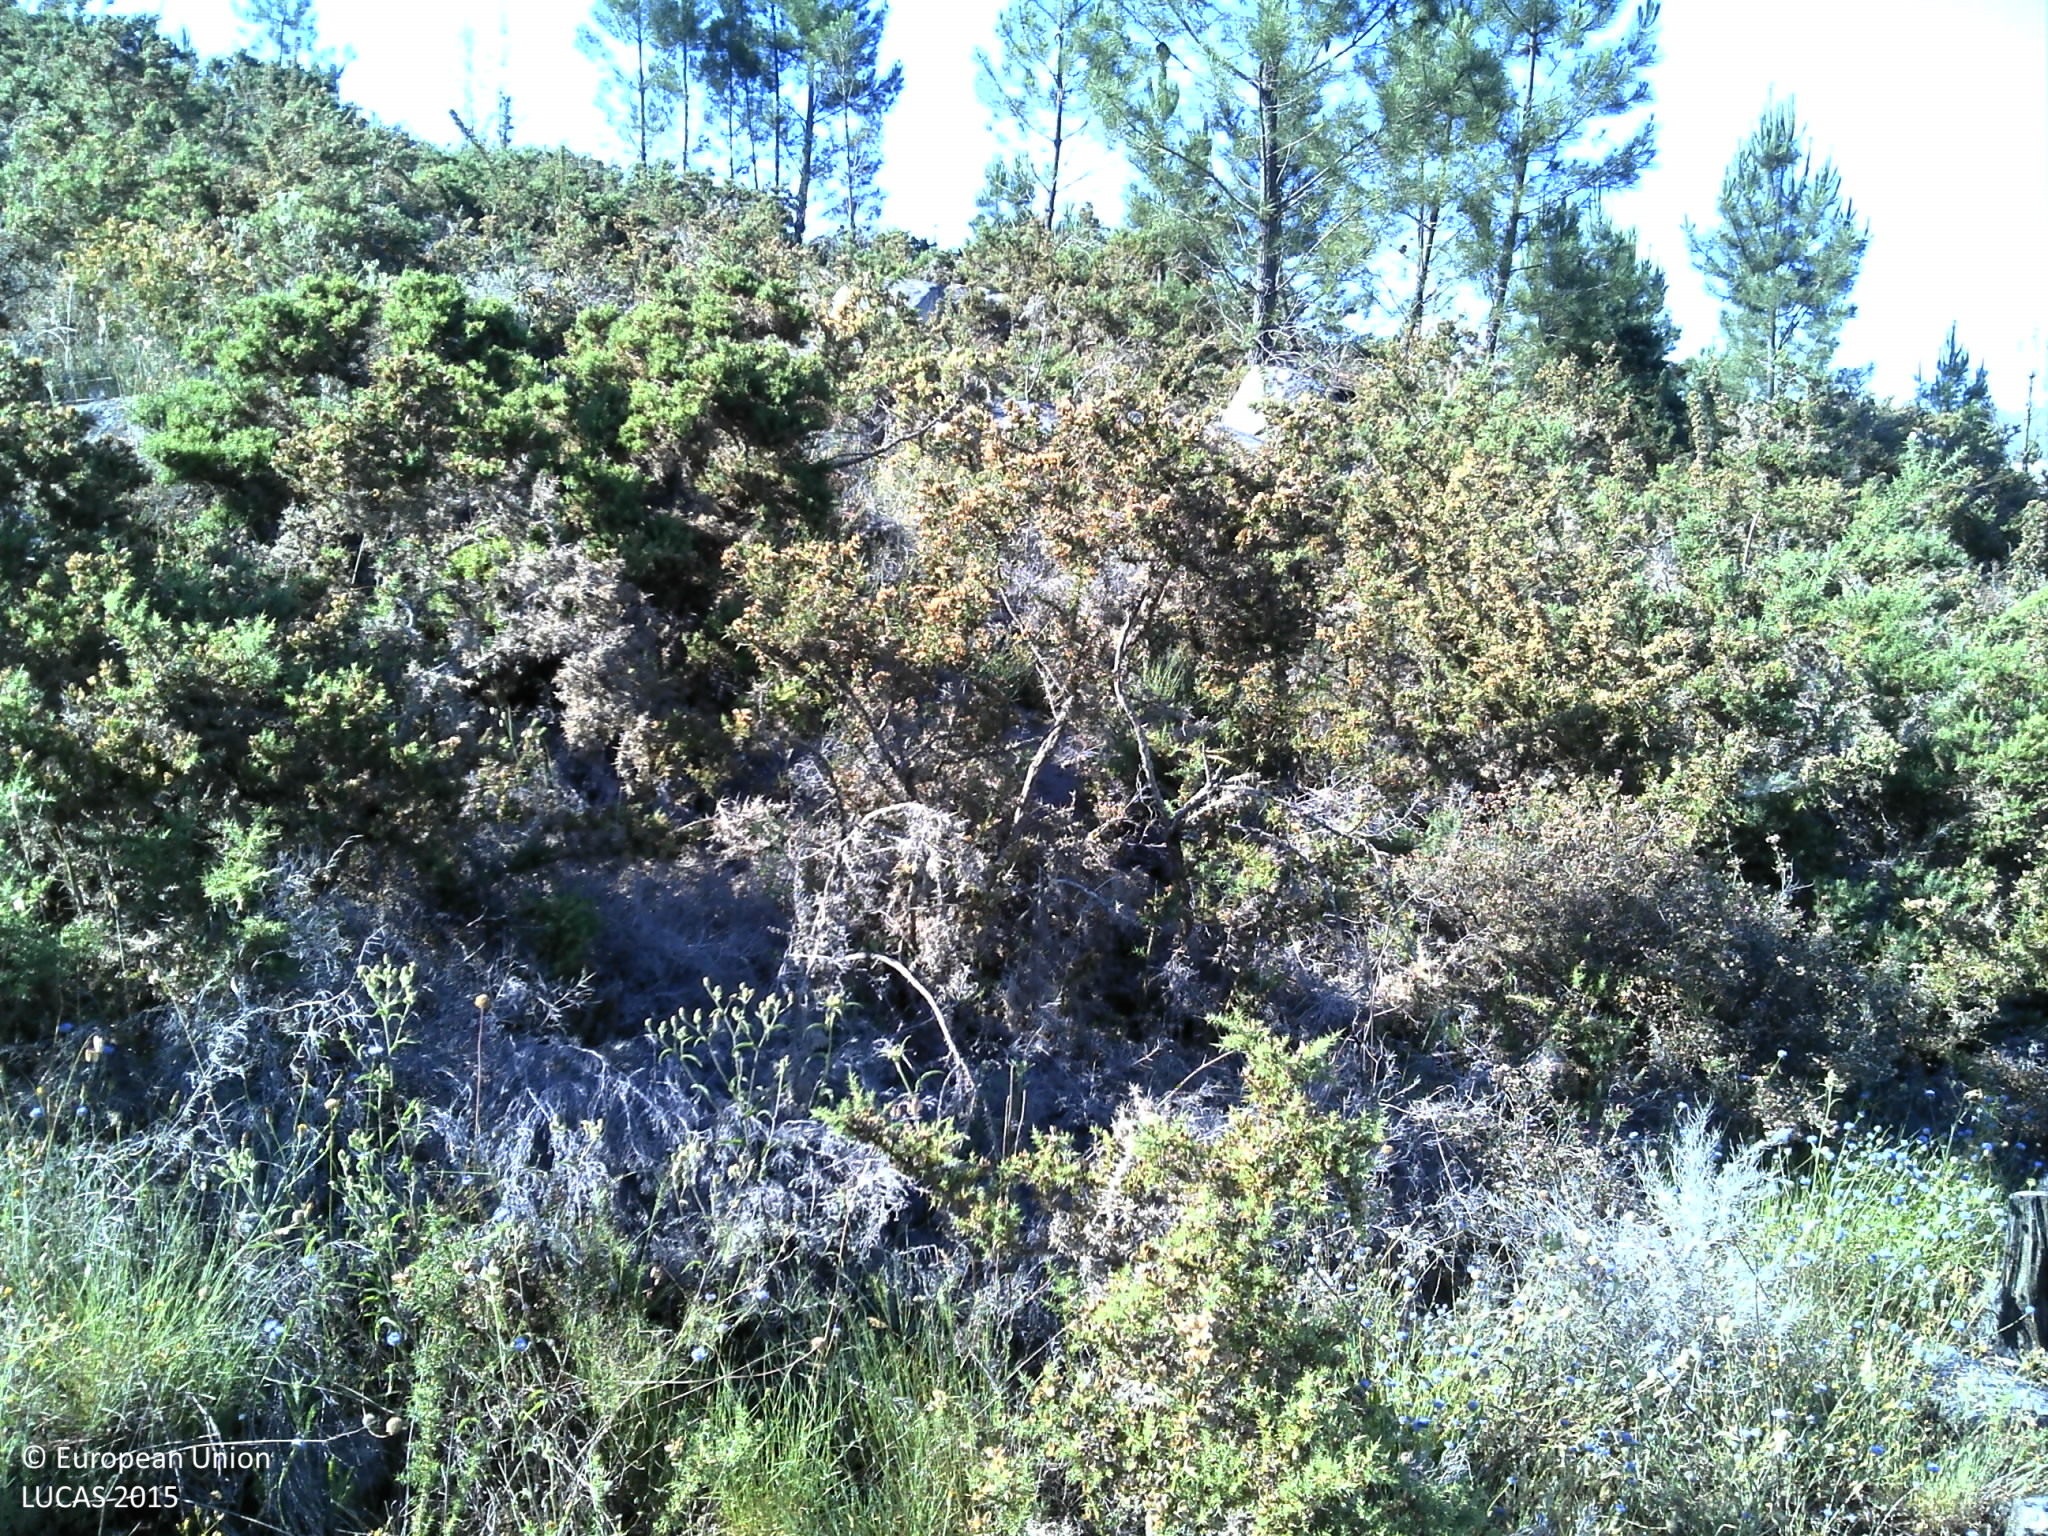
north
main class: Shrubland
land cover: Shrubland without tree cover
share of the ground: > 75 %
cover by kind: shrubs 80 %, herbaceous plants 10 %, unconsolidated bare surface 10 %
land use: Semi-natural and natural areas not in use
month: May
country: PT
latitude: 41.7542
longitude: -8.6488
